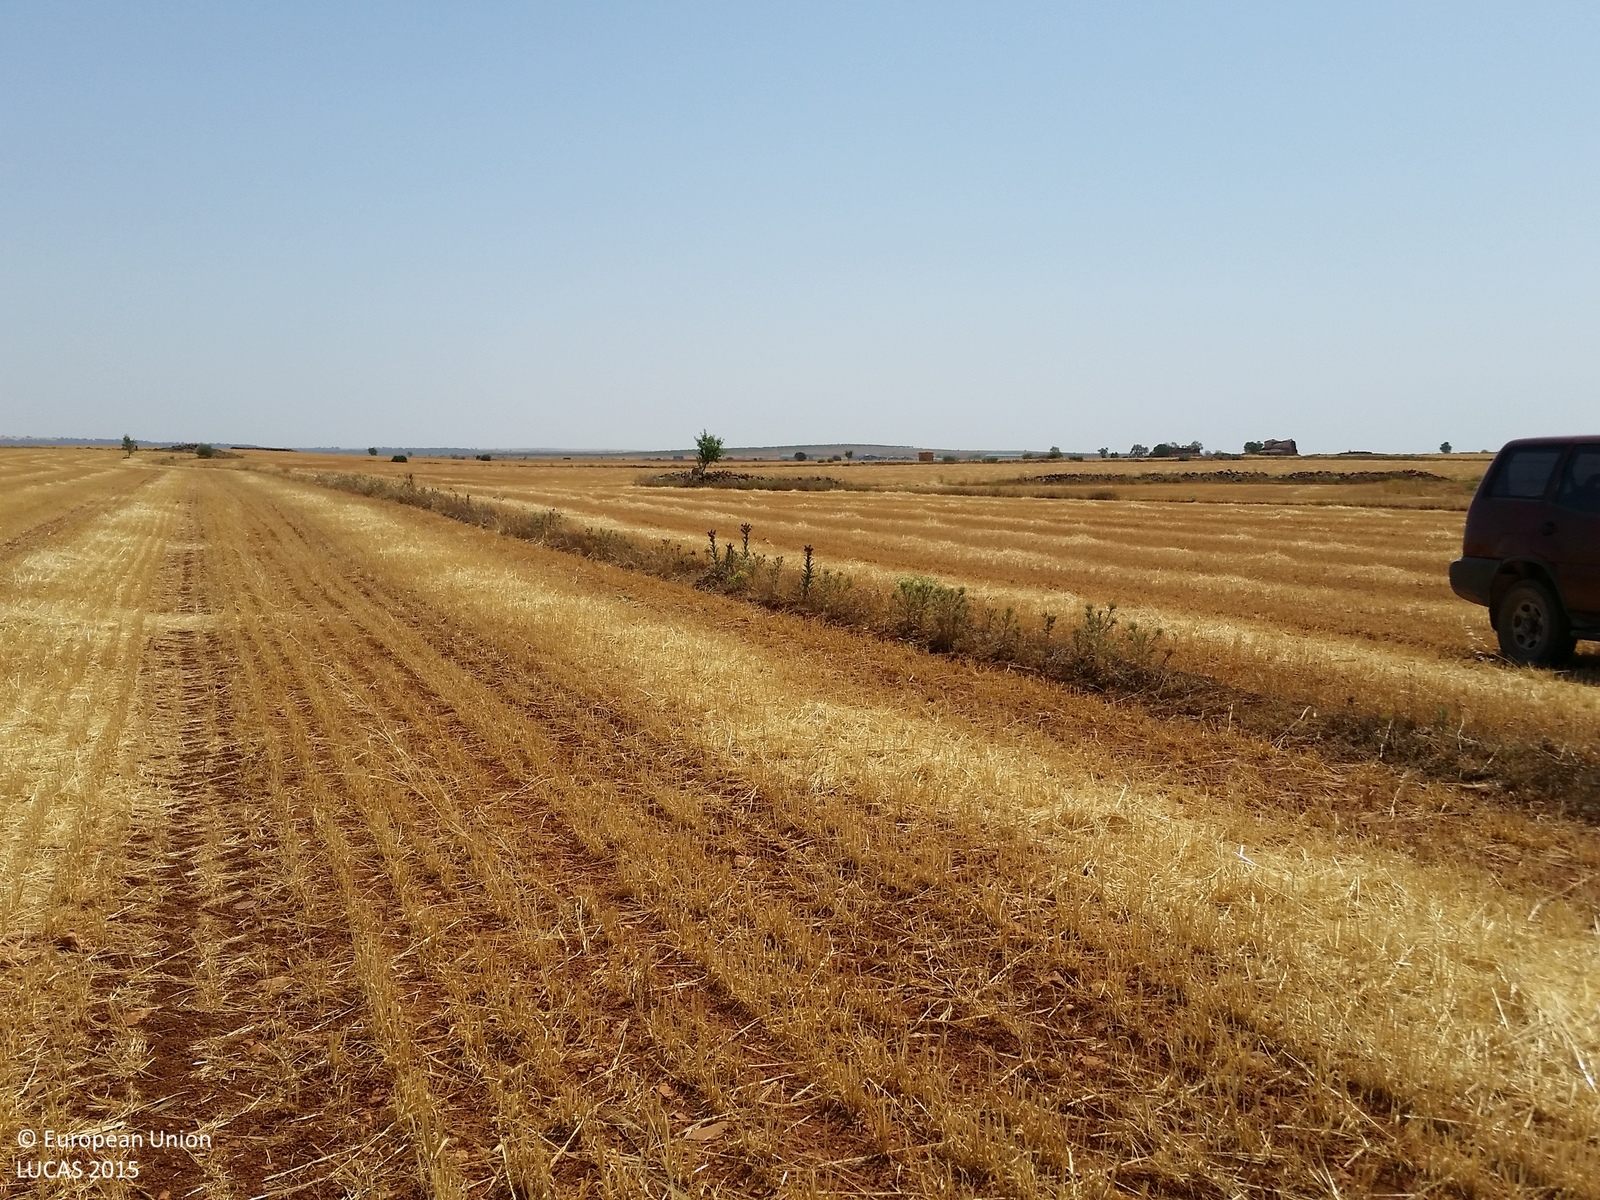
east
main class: Cropland
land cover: Barley
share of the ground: < 10 %
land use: Agriculture (excluding fallow land and kitchen gardens)
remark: Harvested field
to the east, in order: Barley; Grass margins; Barley; Grass margins; Barley; Dry stone walls; Barley
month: July
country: ES
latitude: 38.8836
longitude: -2.6050
